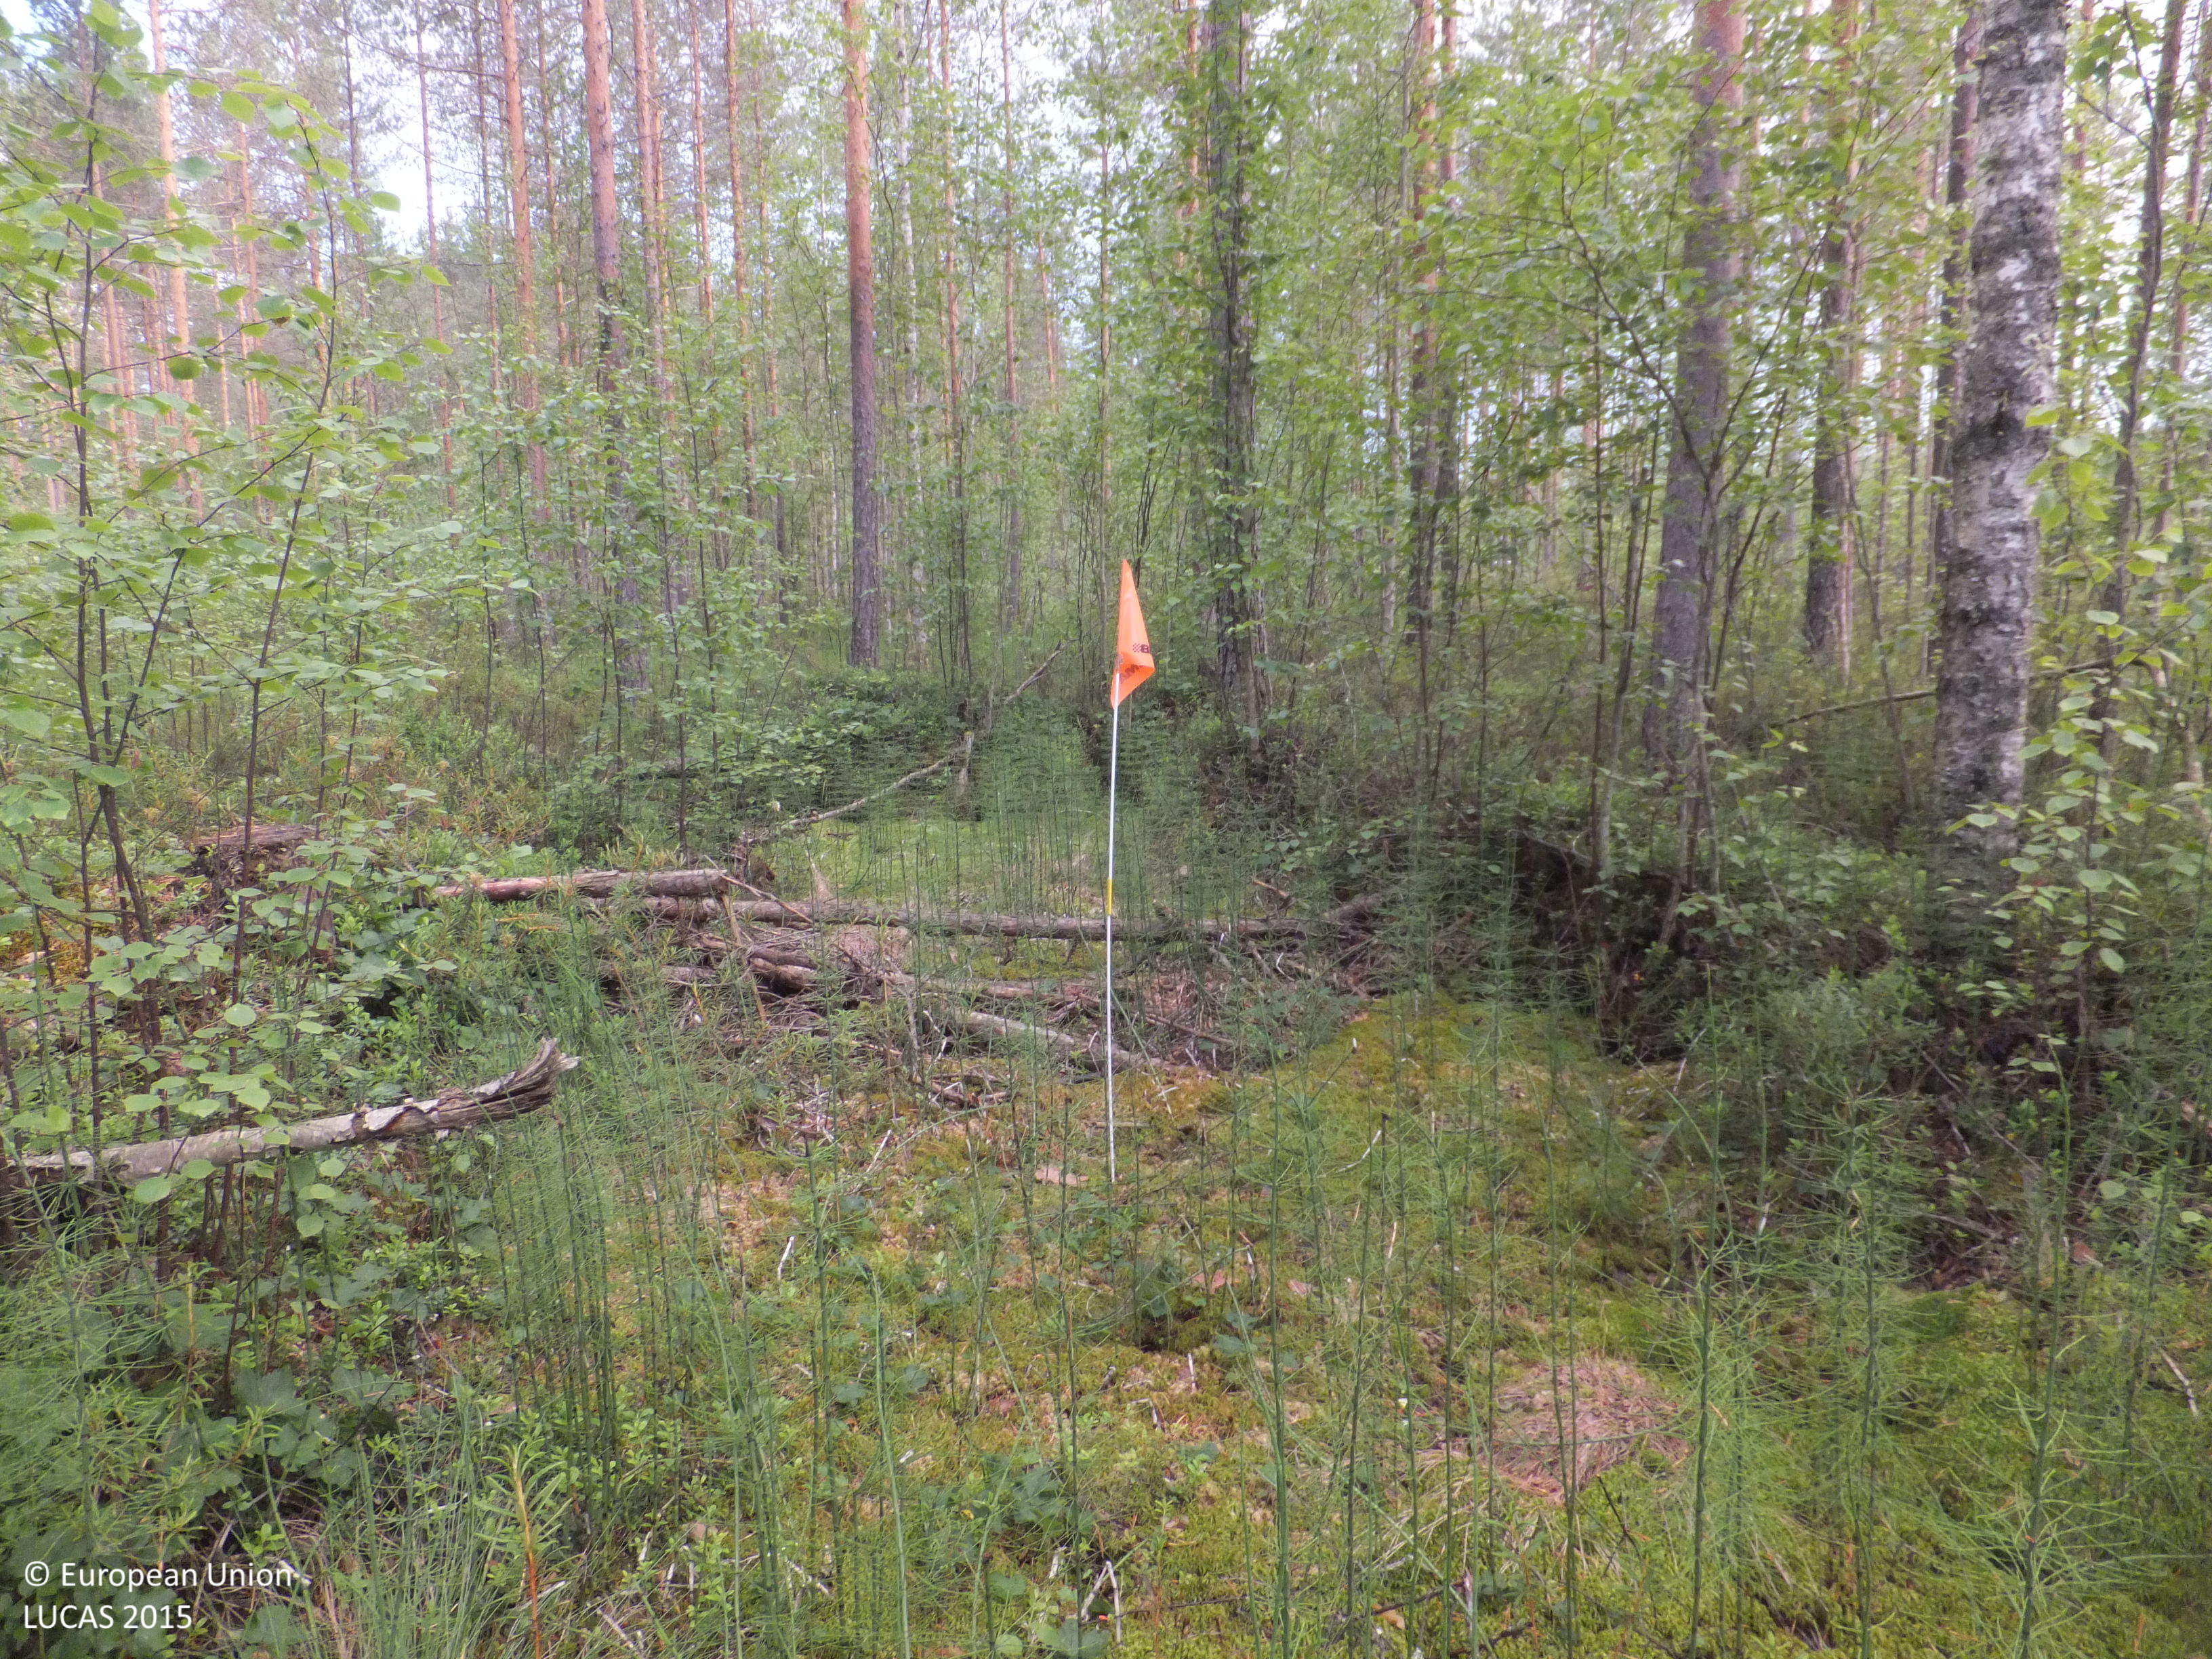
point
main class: Woodland
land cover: Pine dominated mixed woodland
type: boreal forest
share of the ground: > 75 %
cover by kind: coniferous forest trees 40 %, broadleaved forest trees 40 %, shrubs 10 %, herbaceous plants 5 %, lichens and mosses 5 %
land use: Forestry
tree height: > 5 m
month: July
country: FI
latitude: 63.0810
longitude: 24.5176
